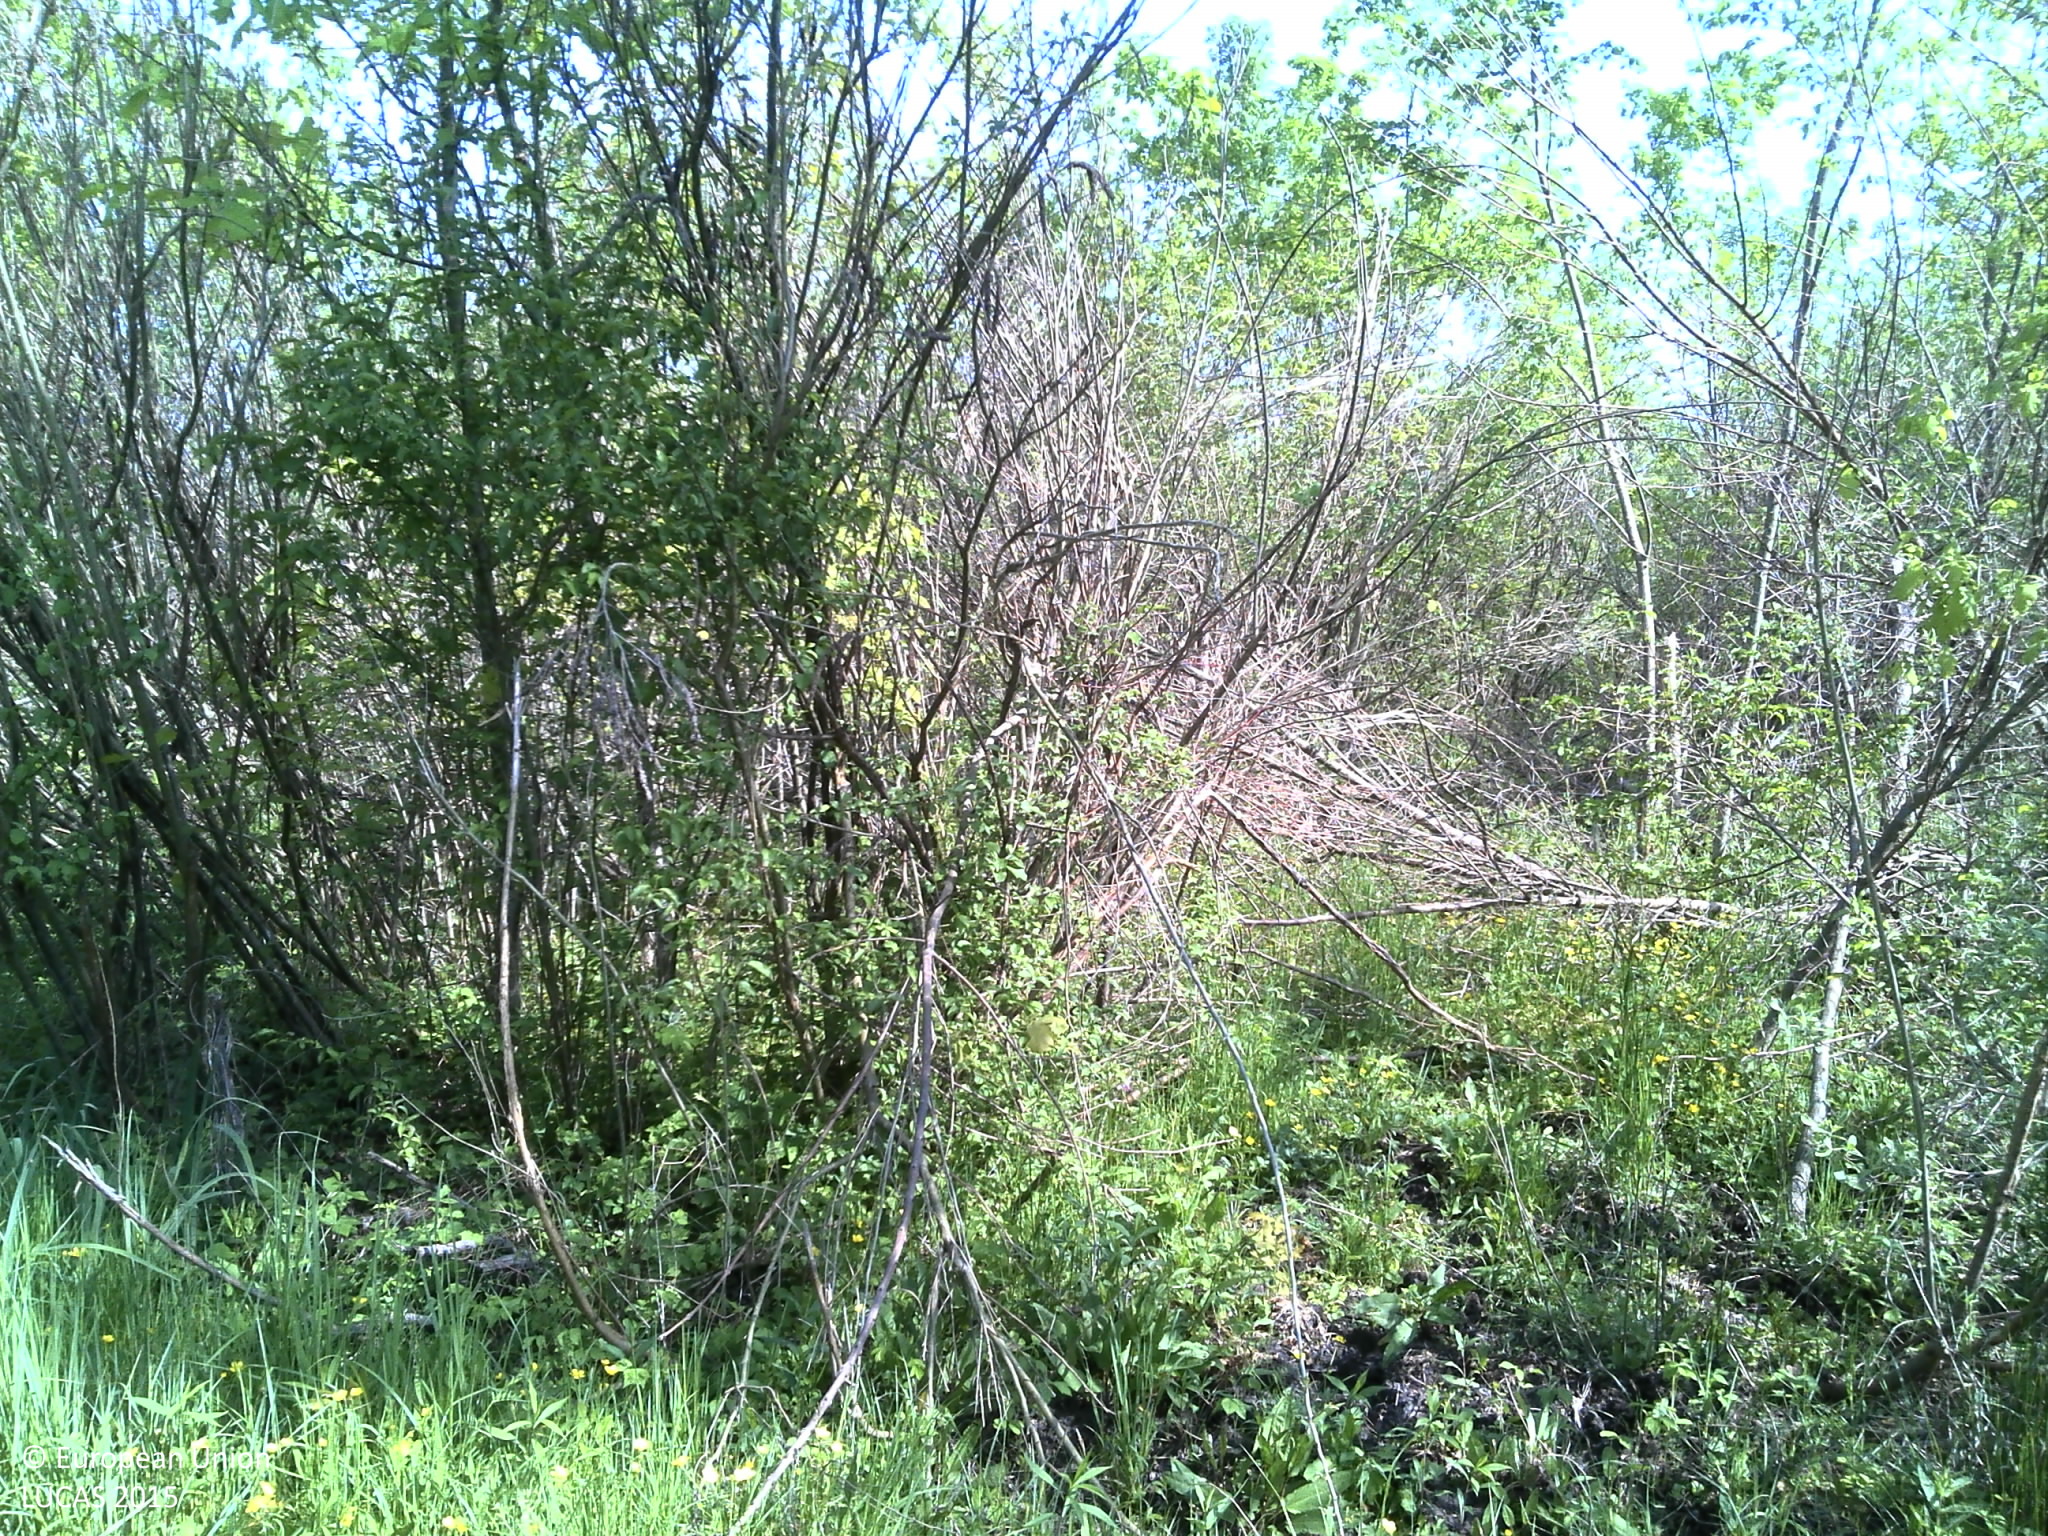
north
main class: Woodland
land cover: Broadleaved woodland
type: mesophytic deciduous forest
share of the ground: > 75 %
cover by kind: broadleaved forest trees 80 %, herbaceous plants 20 %
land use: Forestry
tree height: > 5 m
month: May
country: HR
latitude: 45.2177
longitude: 18.4732
